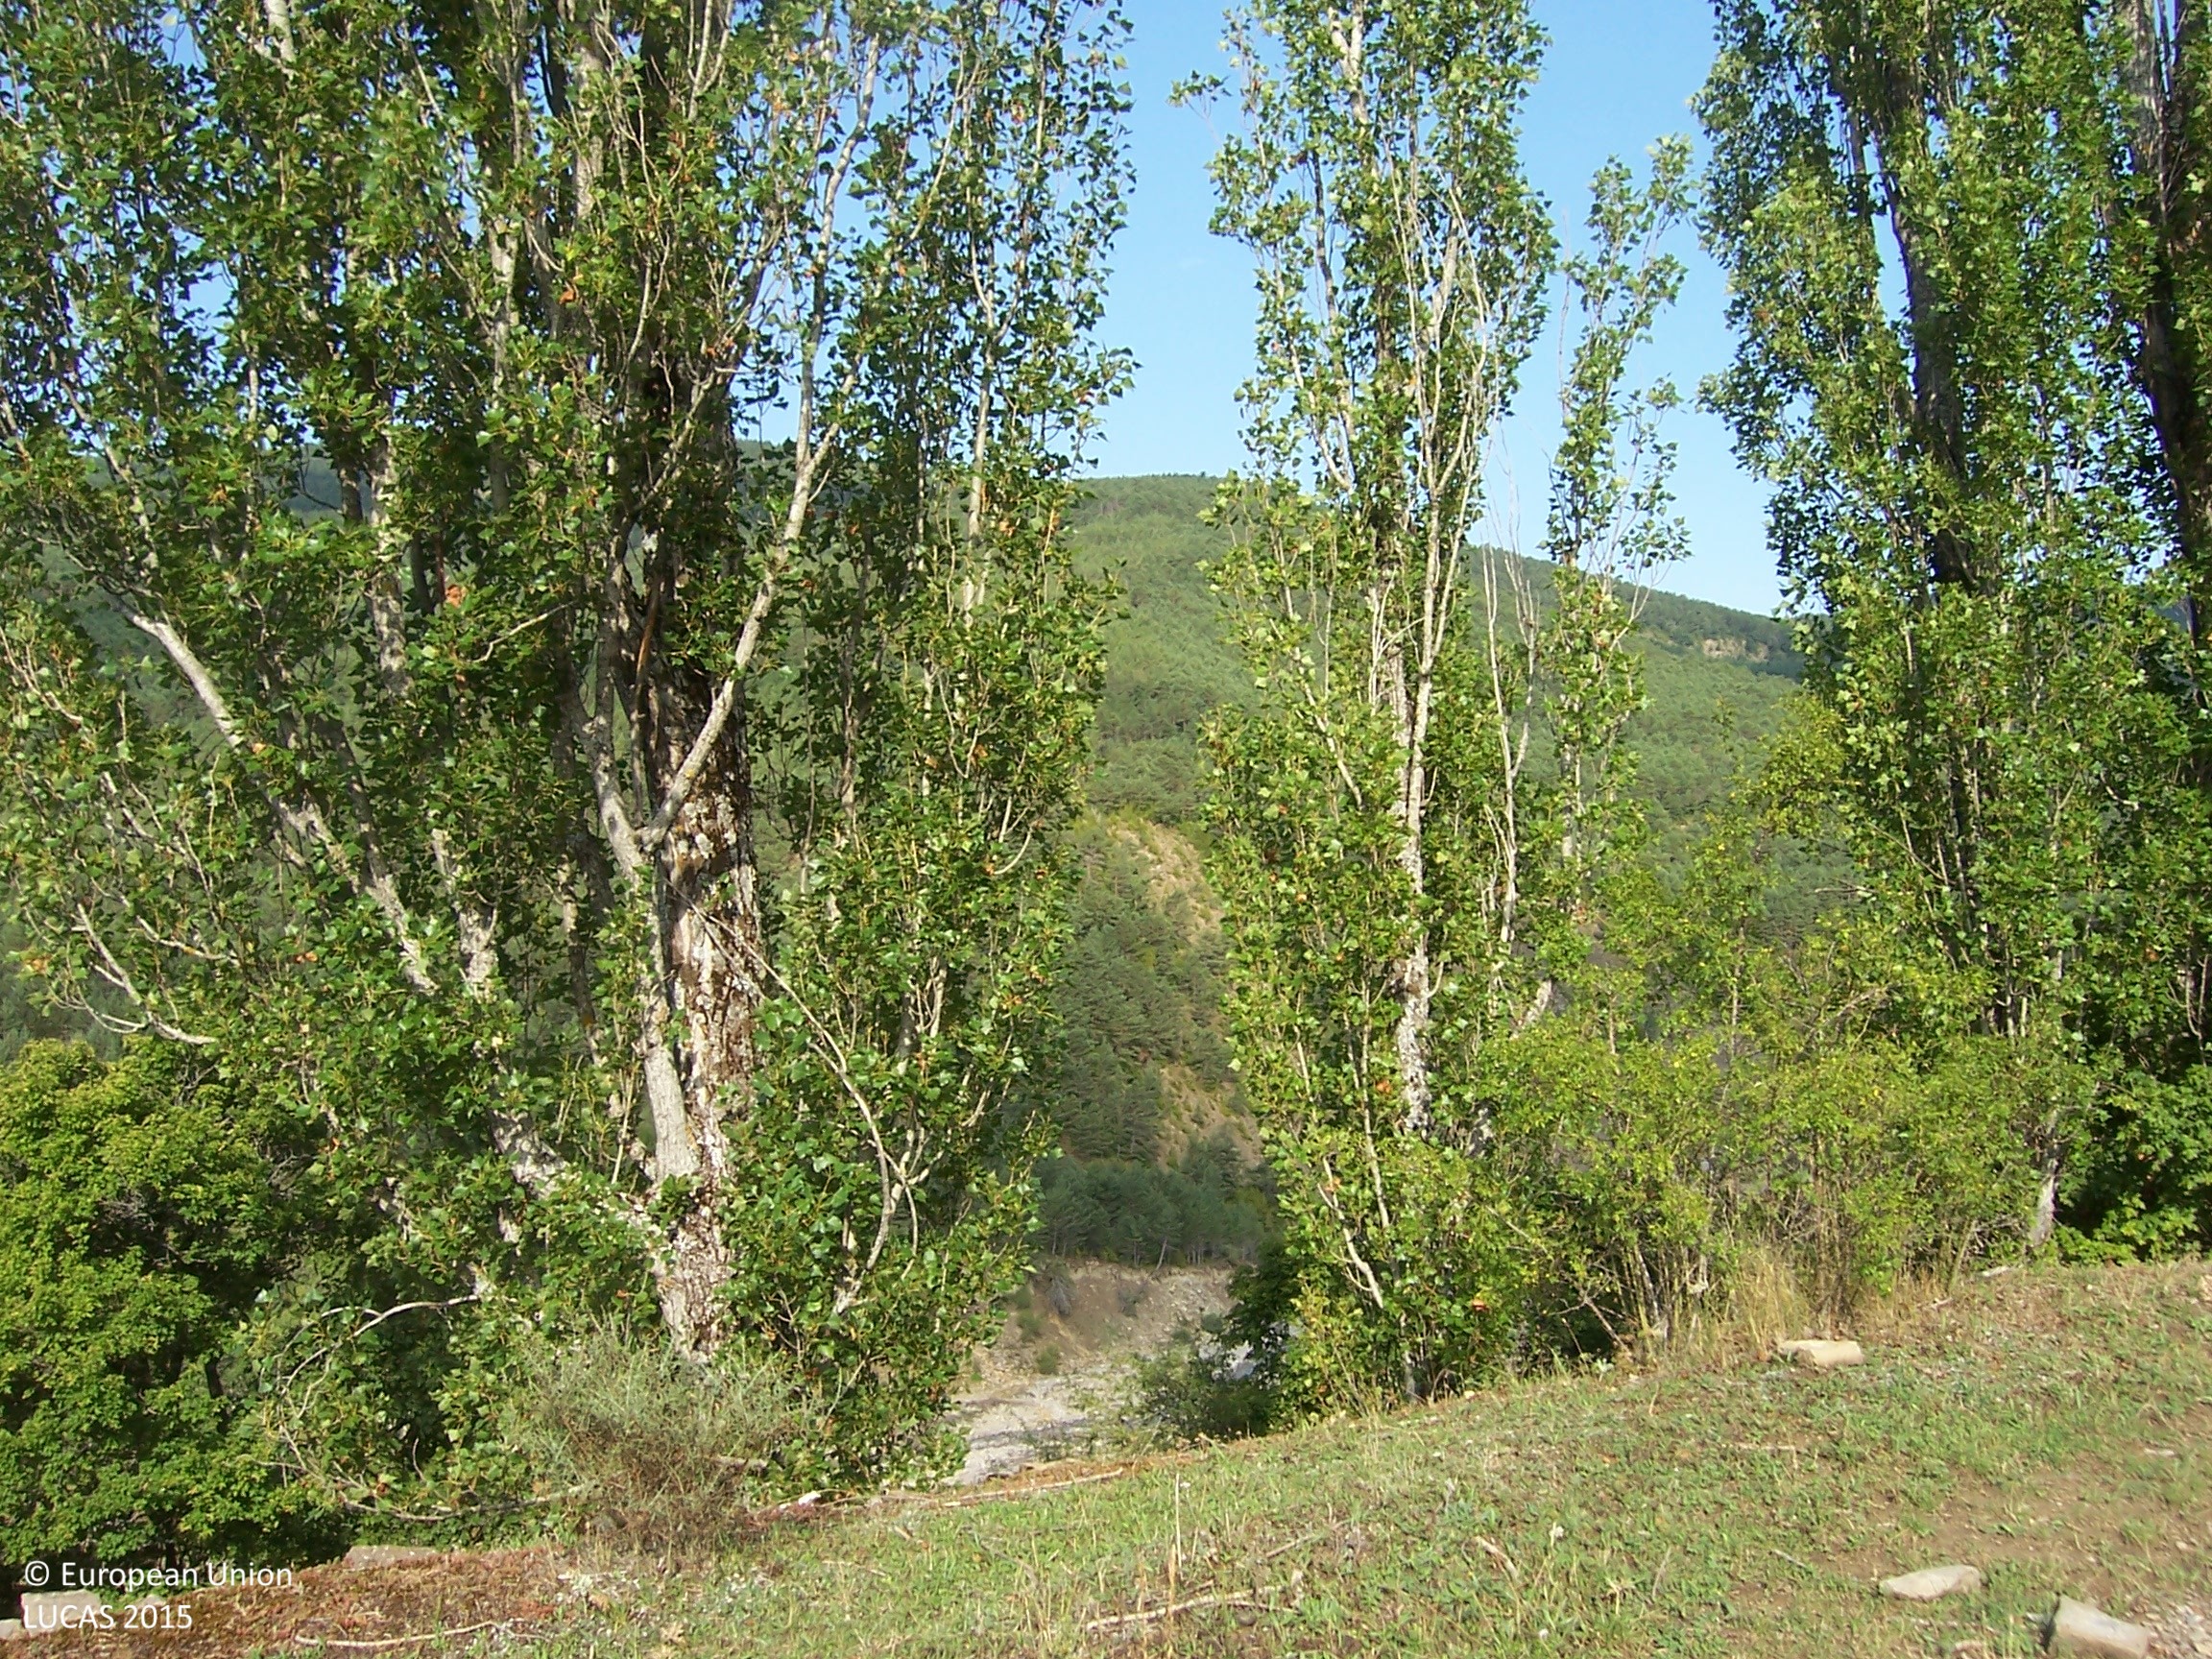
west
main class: Woodland
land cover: Broadleaved woodland
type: floodplain forest
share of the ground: > 75 %
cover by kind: broadleaved forest trees 50 %, herbaceous plants 20 %, consolidated bare surface 20 %, shrubs 10 %
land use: Semi-natural and natural areas not in use
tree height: > 5 m
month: August
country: ES
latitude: 42.6774
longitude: -0.4364
